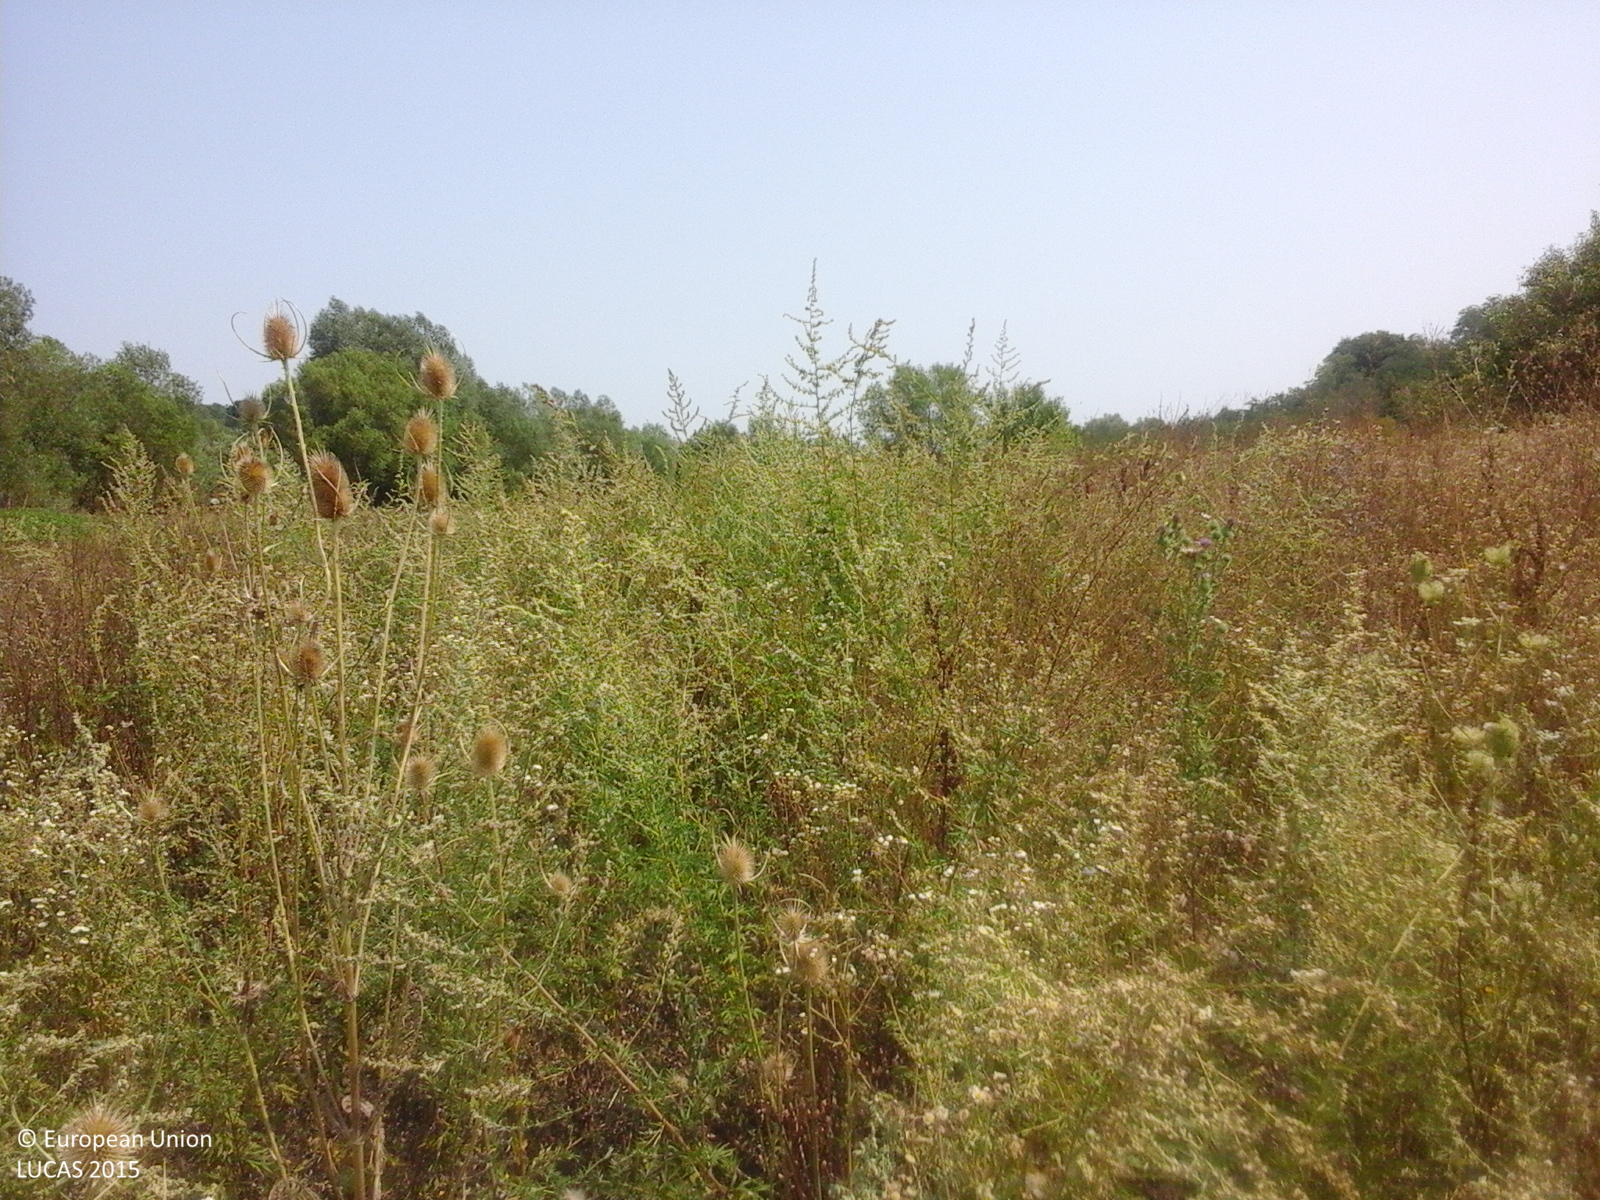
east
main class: Grassland
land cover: Spontaneously vegetated surfaces
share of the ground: > 75 %
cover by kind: herbaceous plants 100 %
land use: Fallow land
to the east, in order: Spontaneously vegetated surfaces; Grassland without tree/shrub cover
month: August
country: RO
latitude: 44.3971
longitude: 23.3456
